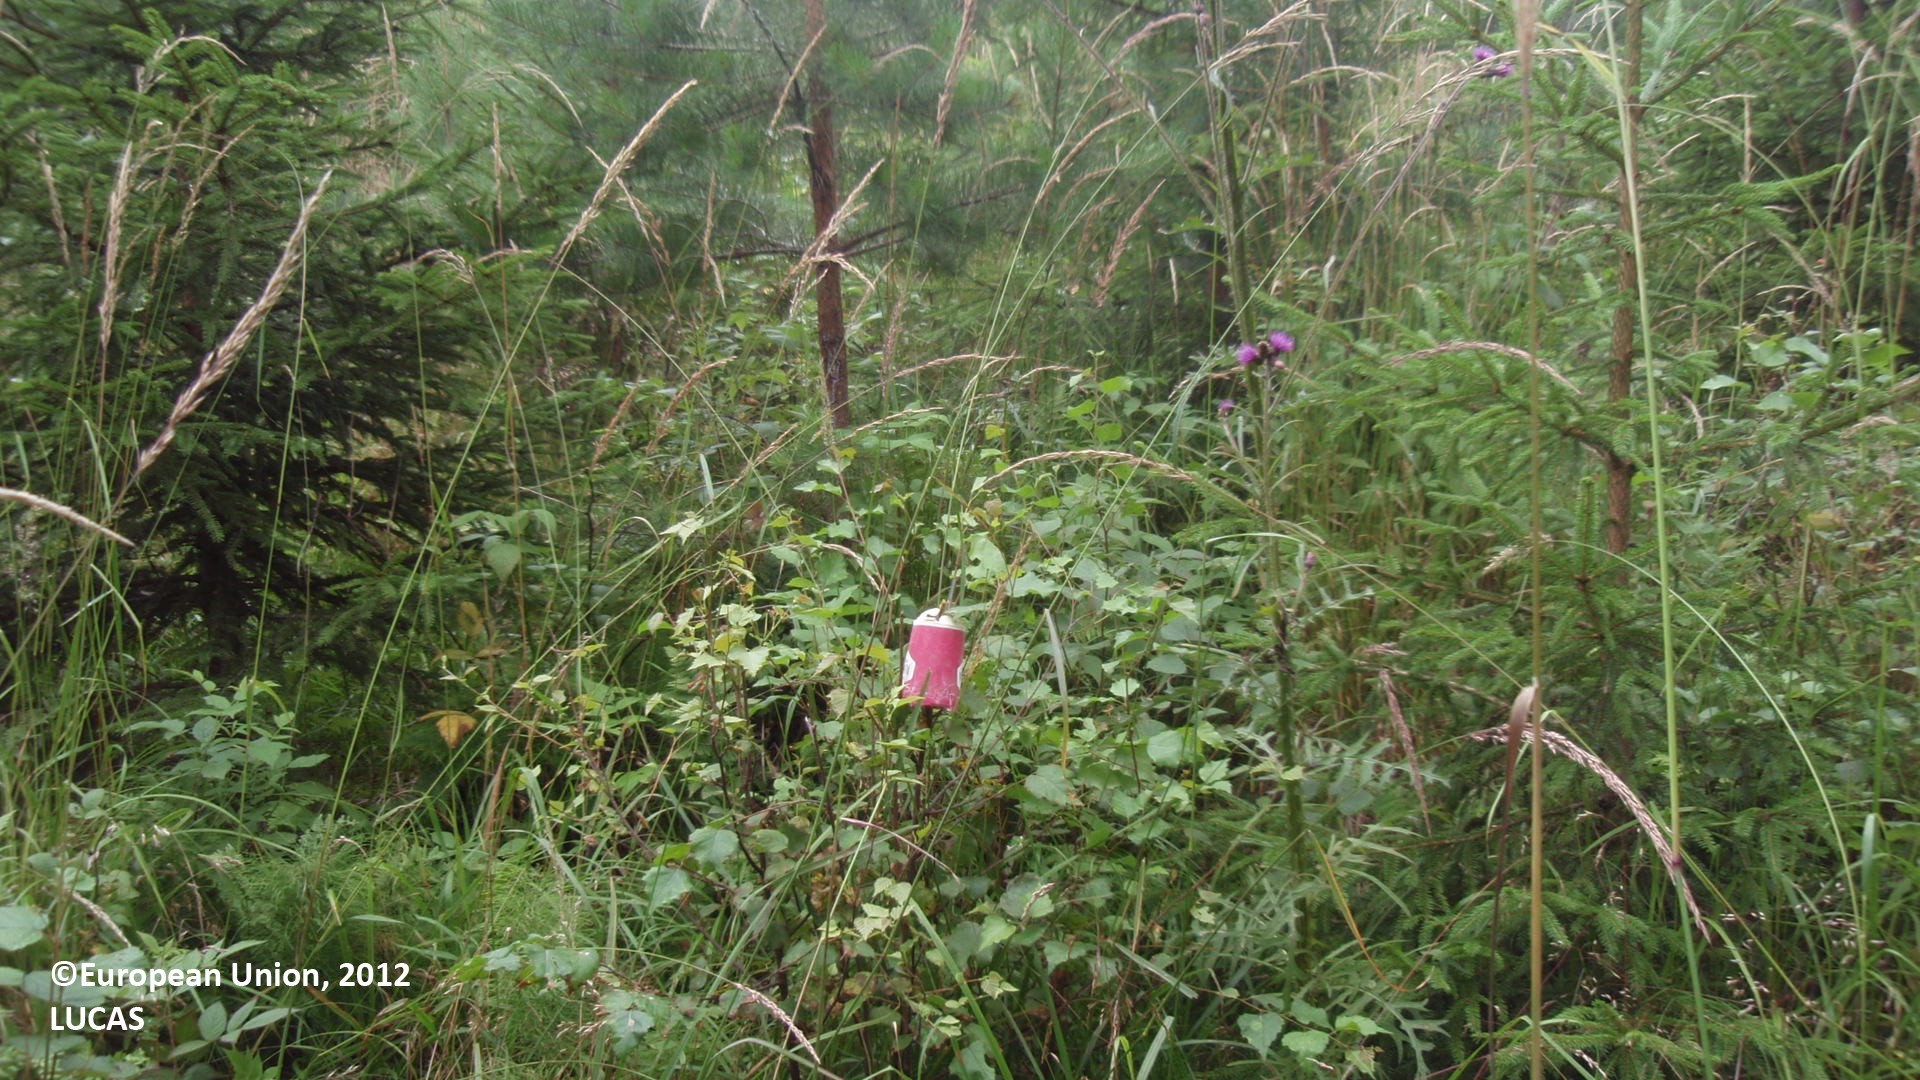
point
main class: Woodland
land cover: Spruce dominated mixed woodland
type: boreal forest
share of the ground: 25 - 50 %
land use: Forestry
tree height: < 5 m
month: August
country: FI
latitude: 60.9070
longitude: 27.4952
